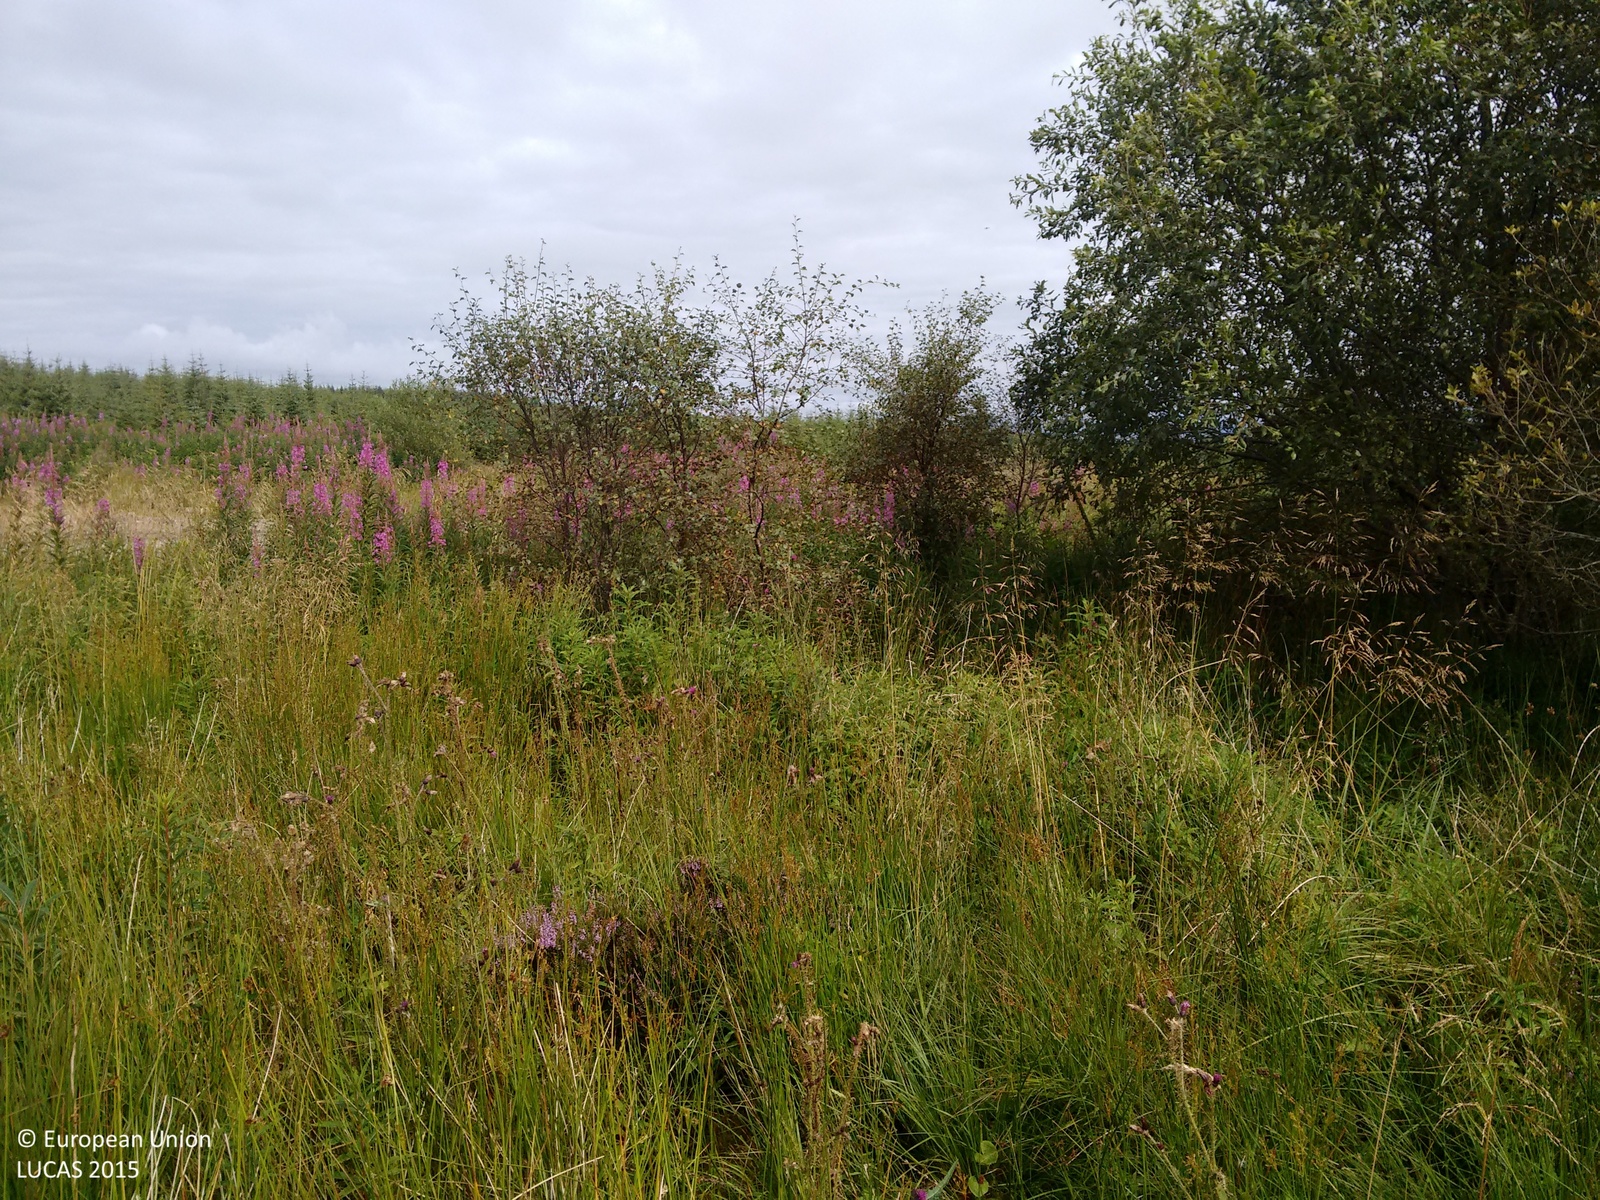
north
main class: Woodland
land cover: Spruce dominated coniferous woodland
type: exotic forest
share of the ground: > 75 %
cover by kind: coniferous forest trees 100 %
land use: Forestry
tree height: > 5 m
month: September
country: GB
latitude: 55.2416
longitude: -4.5560
